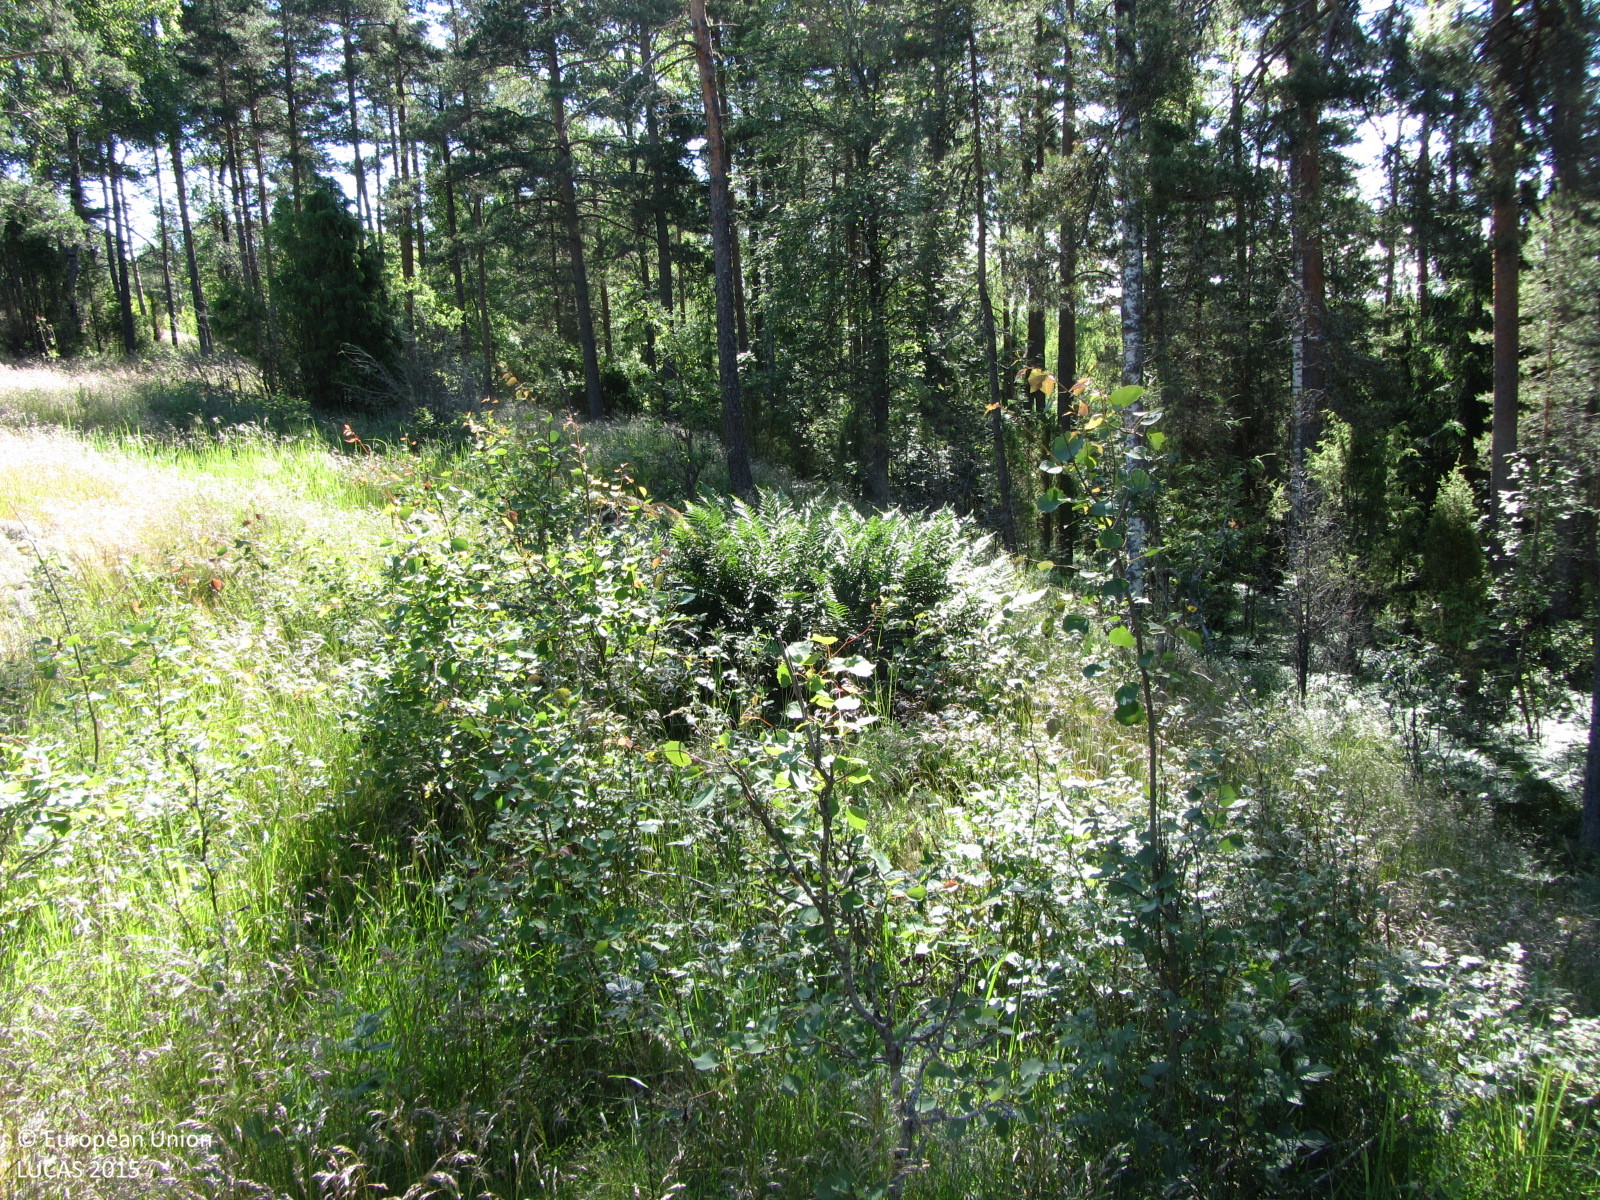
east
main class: Grassland
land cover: Grassland with sparse tree/shrub cover
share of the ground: 50 - 75 %
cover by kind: herbaceous plants 70 %, lichens and mosses 25 %, broadleaved forest trees 5 %
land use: Forestry
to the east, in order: Grassland with sparse tree/shrub cover; Electric lines; Pine dominated mixed woodland; Tracks; Pine dominated mixed woodland; Artificial constructions in urban areas; Pine dominated mixed woodland; Inland marshes; Inland fresh water bodies; Pine dominated coniferous woodland
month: July
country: FI
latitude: 60.0914
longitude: 23.1546
